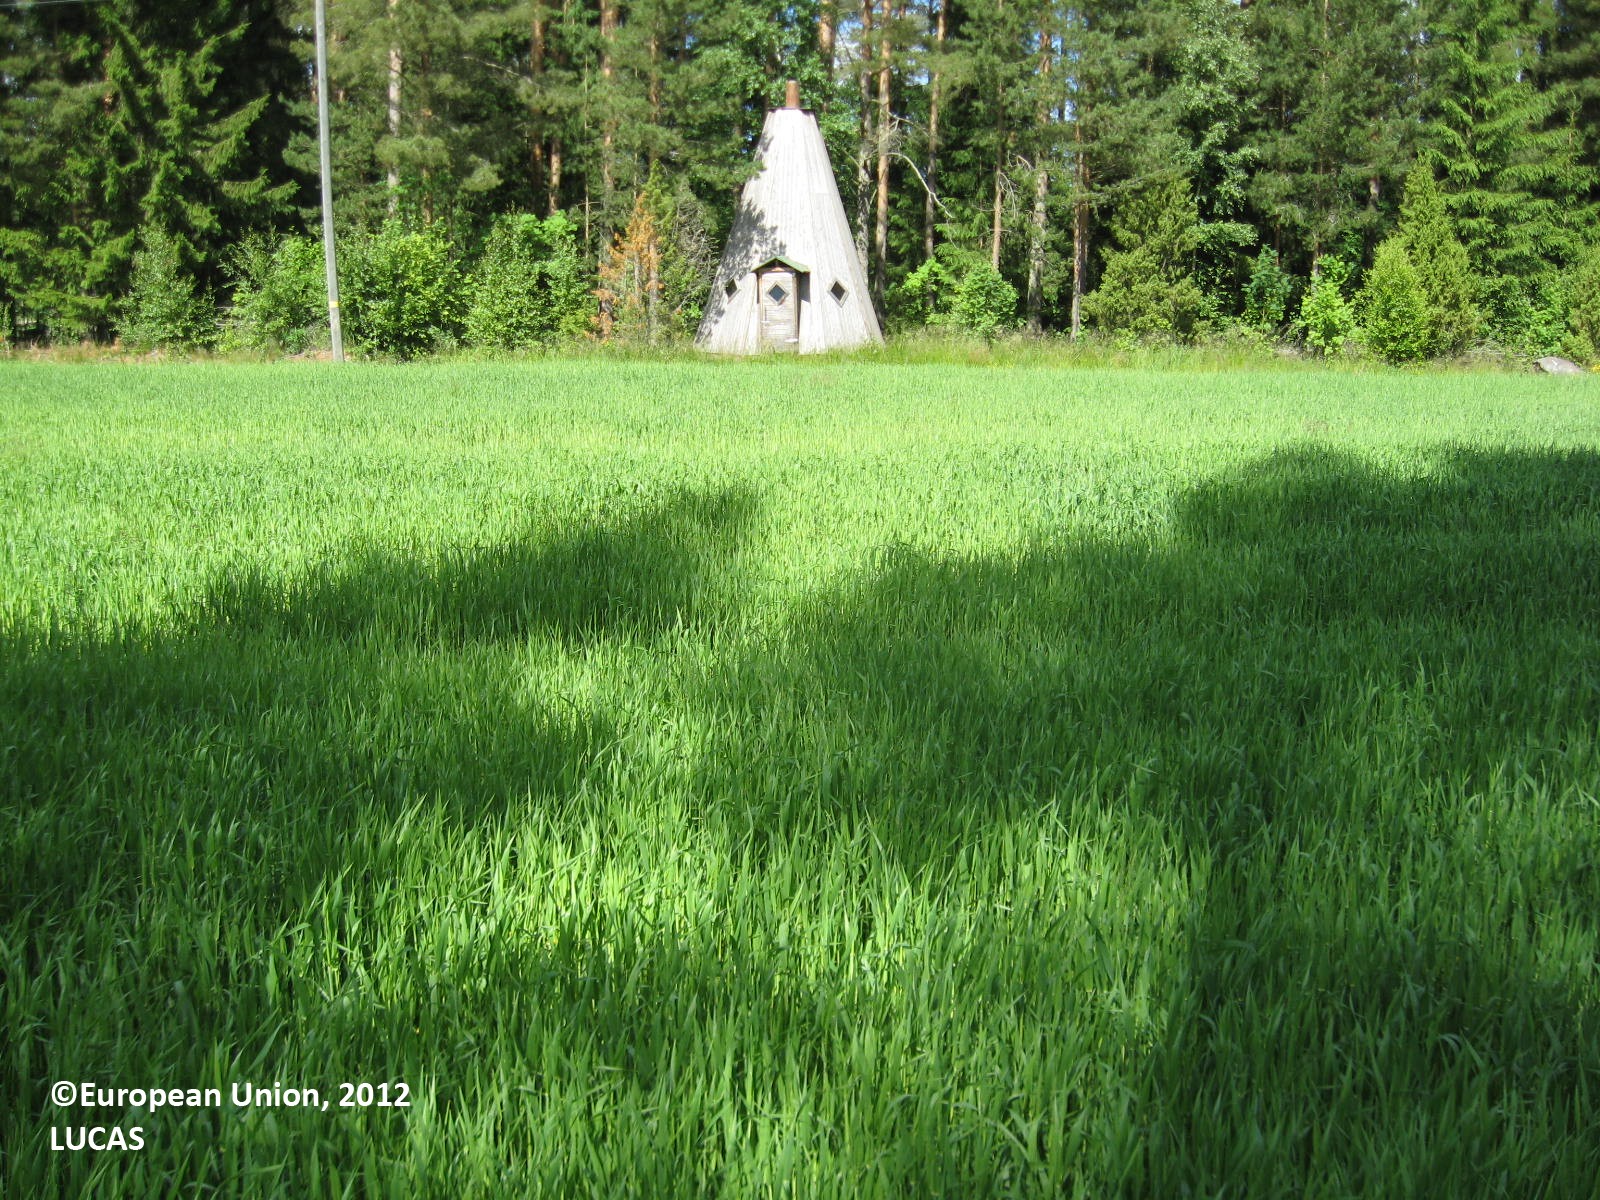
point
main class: Cropland
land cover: Barley
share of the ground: > 75 %
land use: Agriculture (excluding fallow land and kitchen gardens)
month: June
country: FI
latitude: 62.7959
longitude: 22.5833
